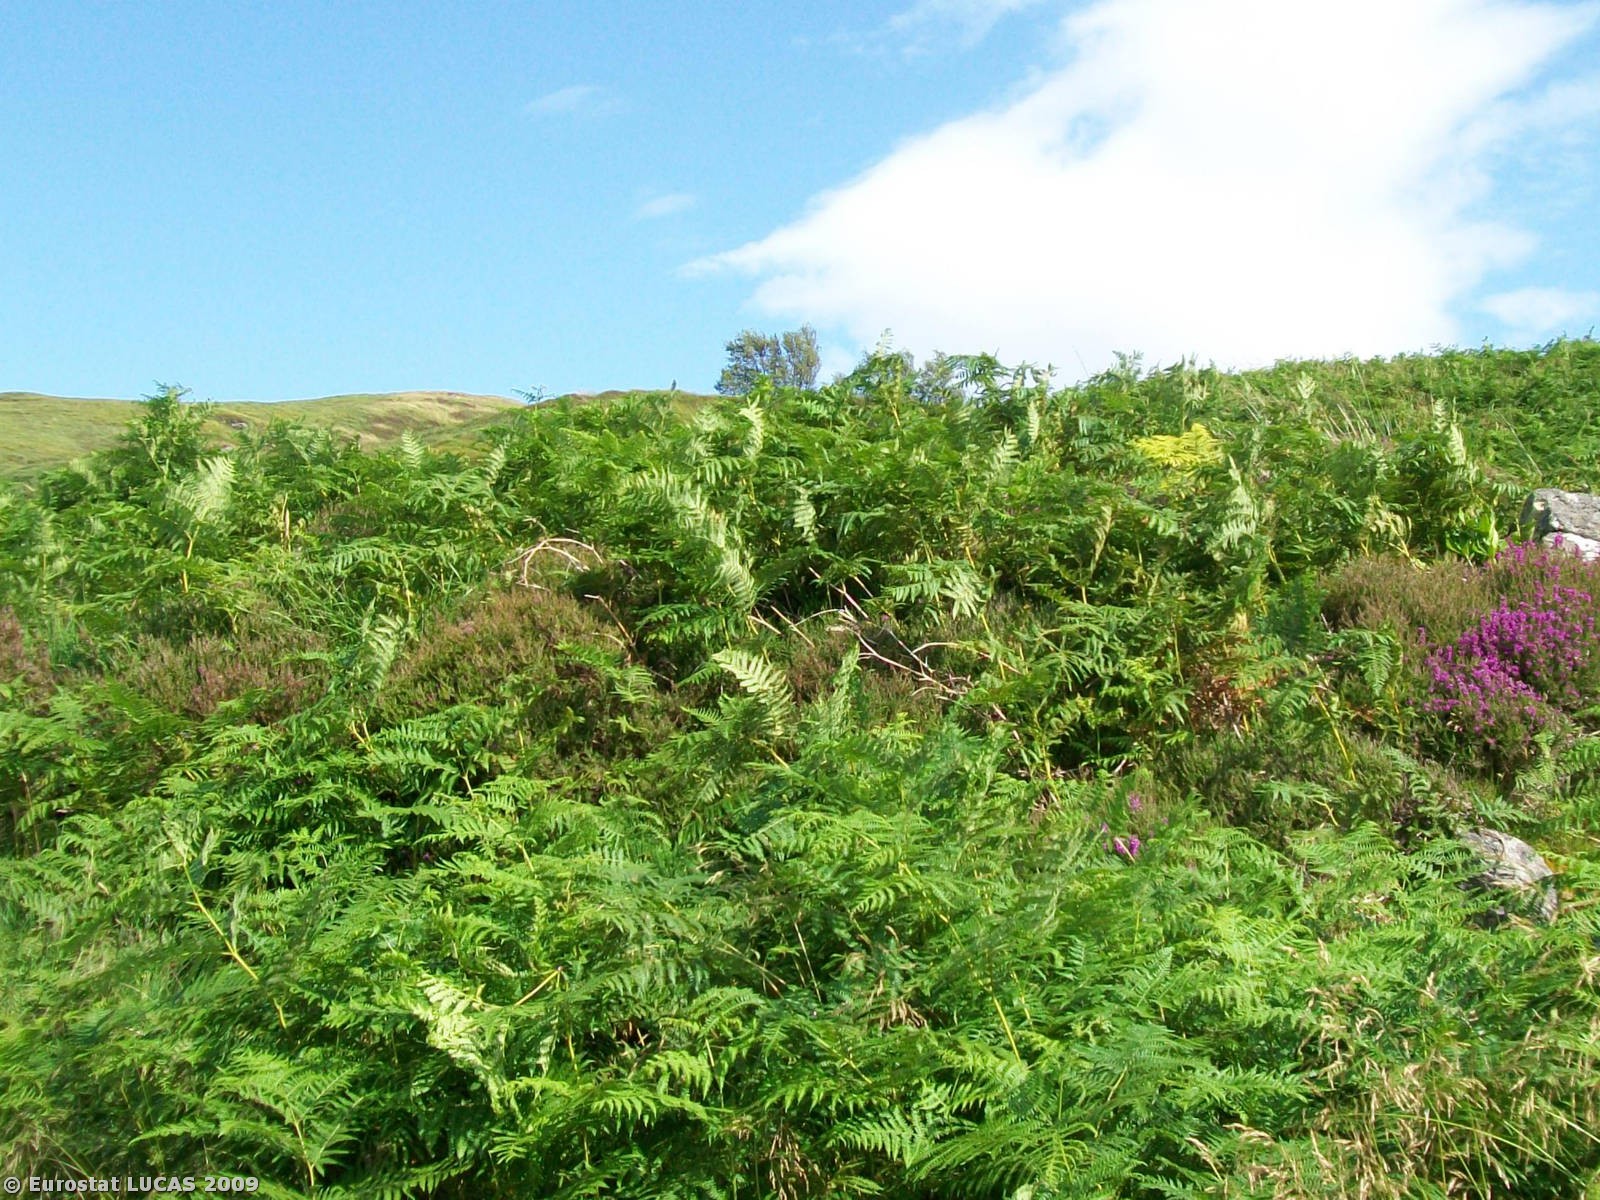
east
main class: Shrubland
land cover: Shrubland without tree cover
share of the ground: > 75 %
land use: Fallow land
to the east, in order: Shrubland without tree cover; Grassland without tree/shrub cover; Shrubland without tree cover; Grassland without tree/shrub cover; Shrubland without tree cover; Broadleaved woodland; Shrubland without tree cover; Rock outcrops; Shrubland without tree cover
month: July
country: GB
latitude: 57.2044
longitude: -5.6308
